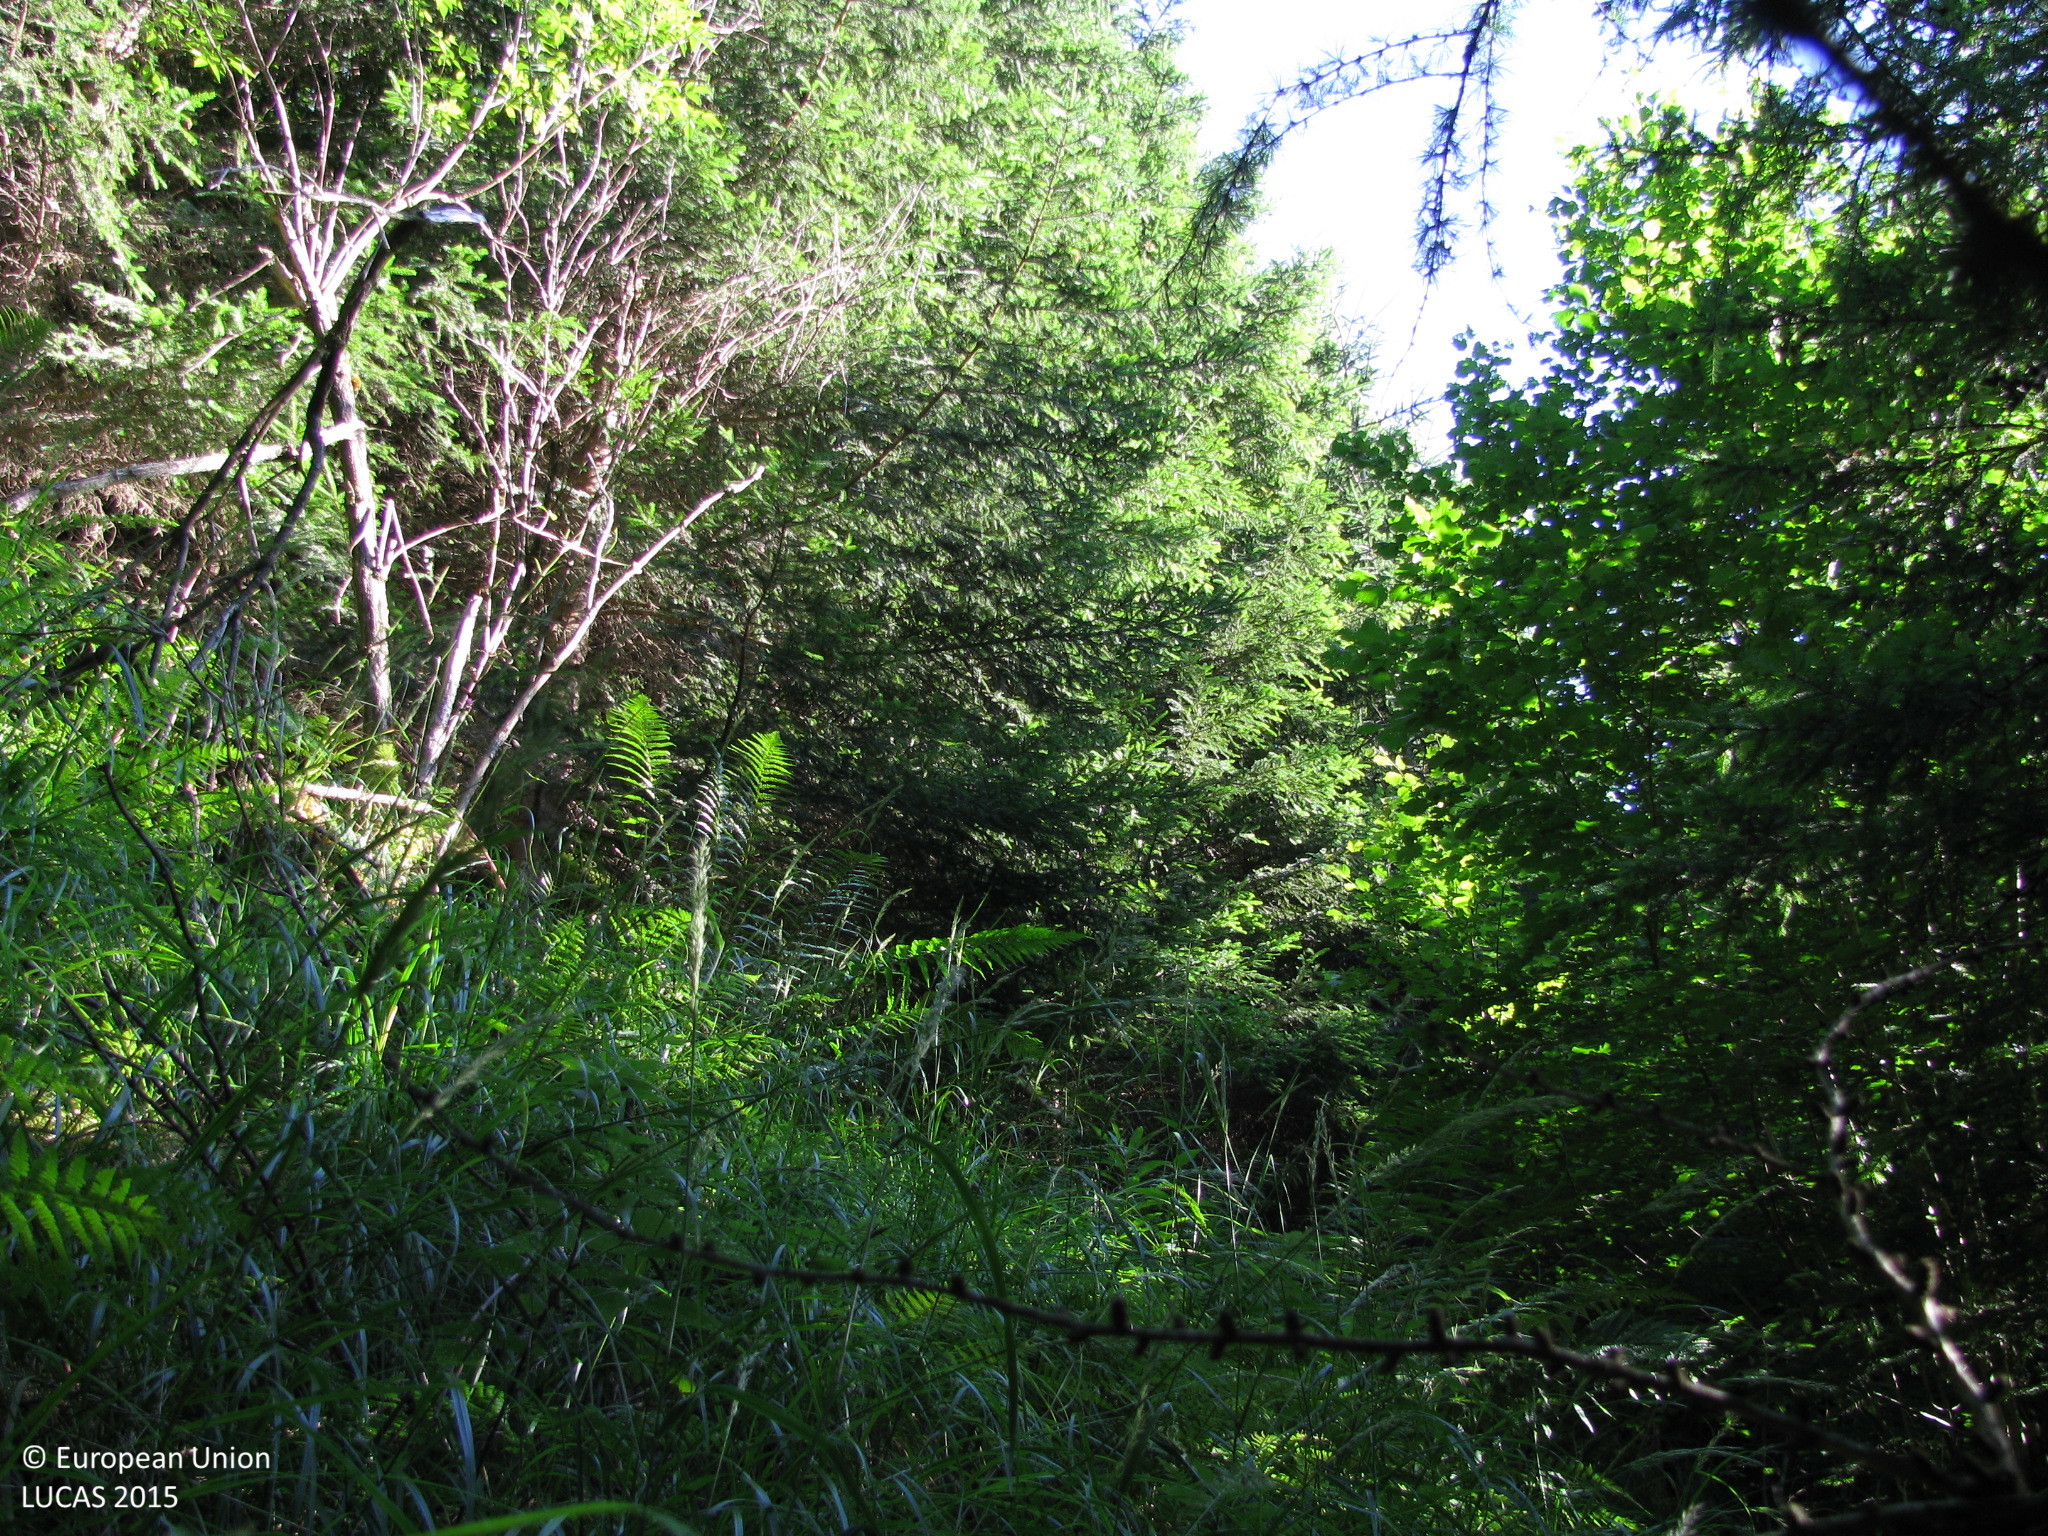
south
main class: Woodland
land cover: Spruce dominated coniferous woodland
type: alpine coniferous forest
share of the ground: > 75 %
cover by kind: coniferous forest trees 80 %, herbaceous plants 15 %, shrubs 5 %
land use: Forestry
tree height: > 5 m
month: July
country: AT
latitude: 47.2467
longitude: 14.9538
